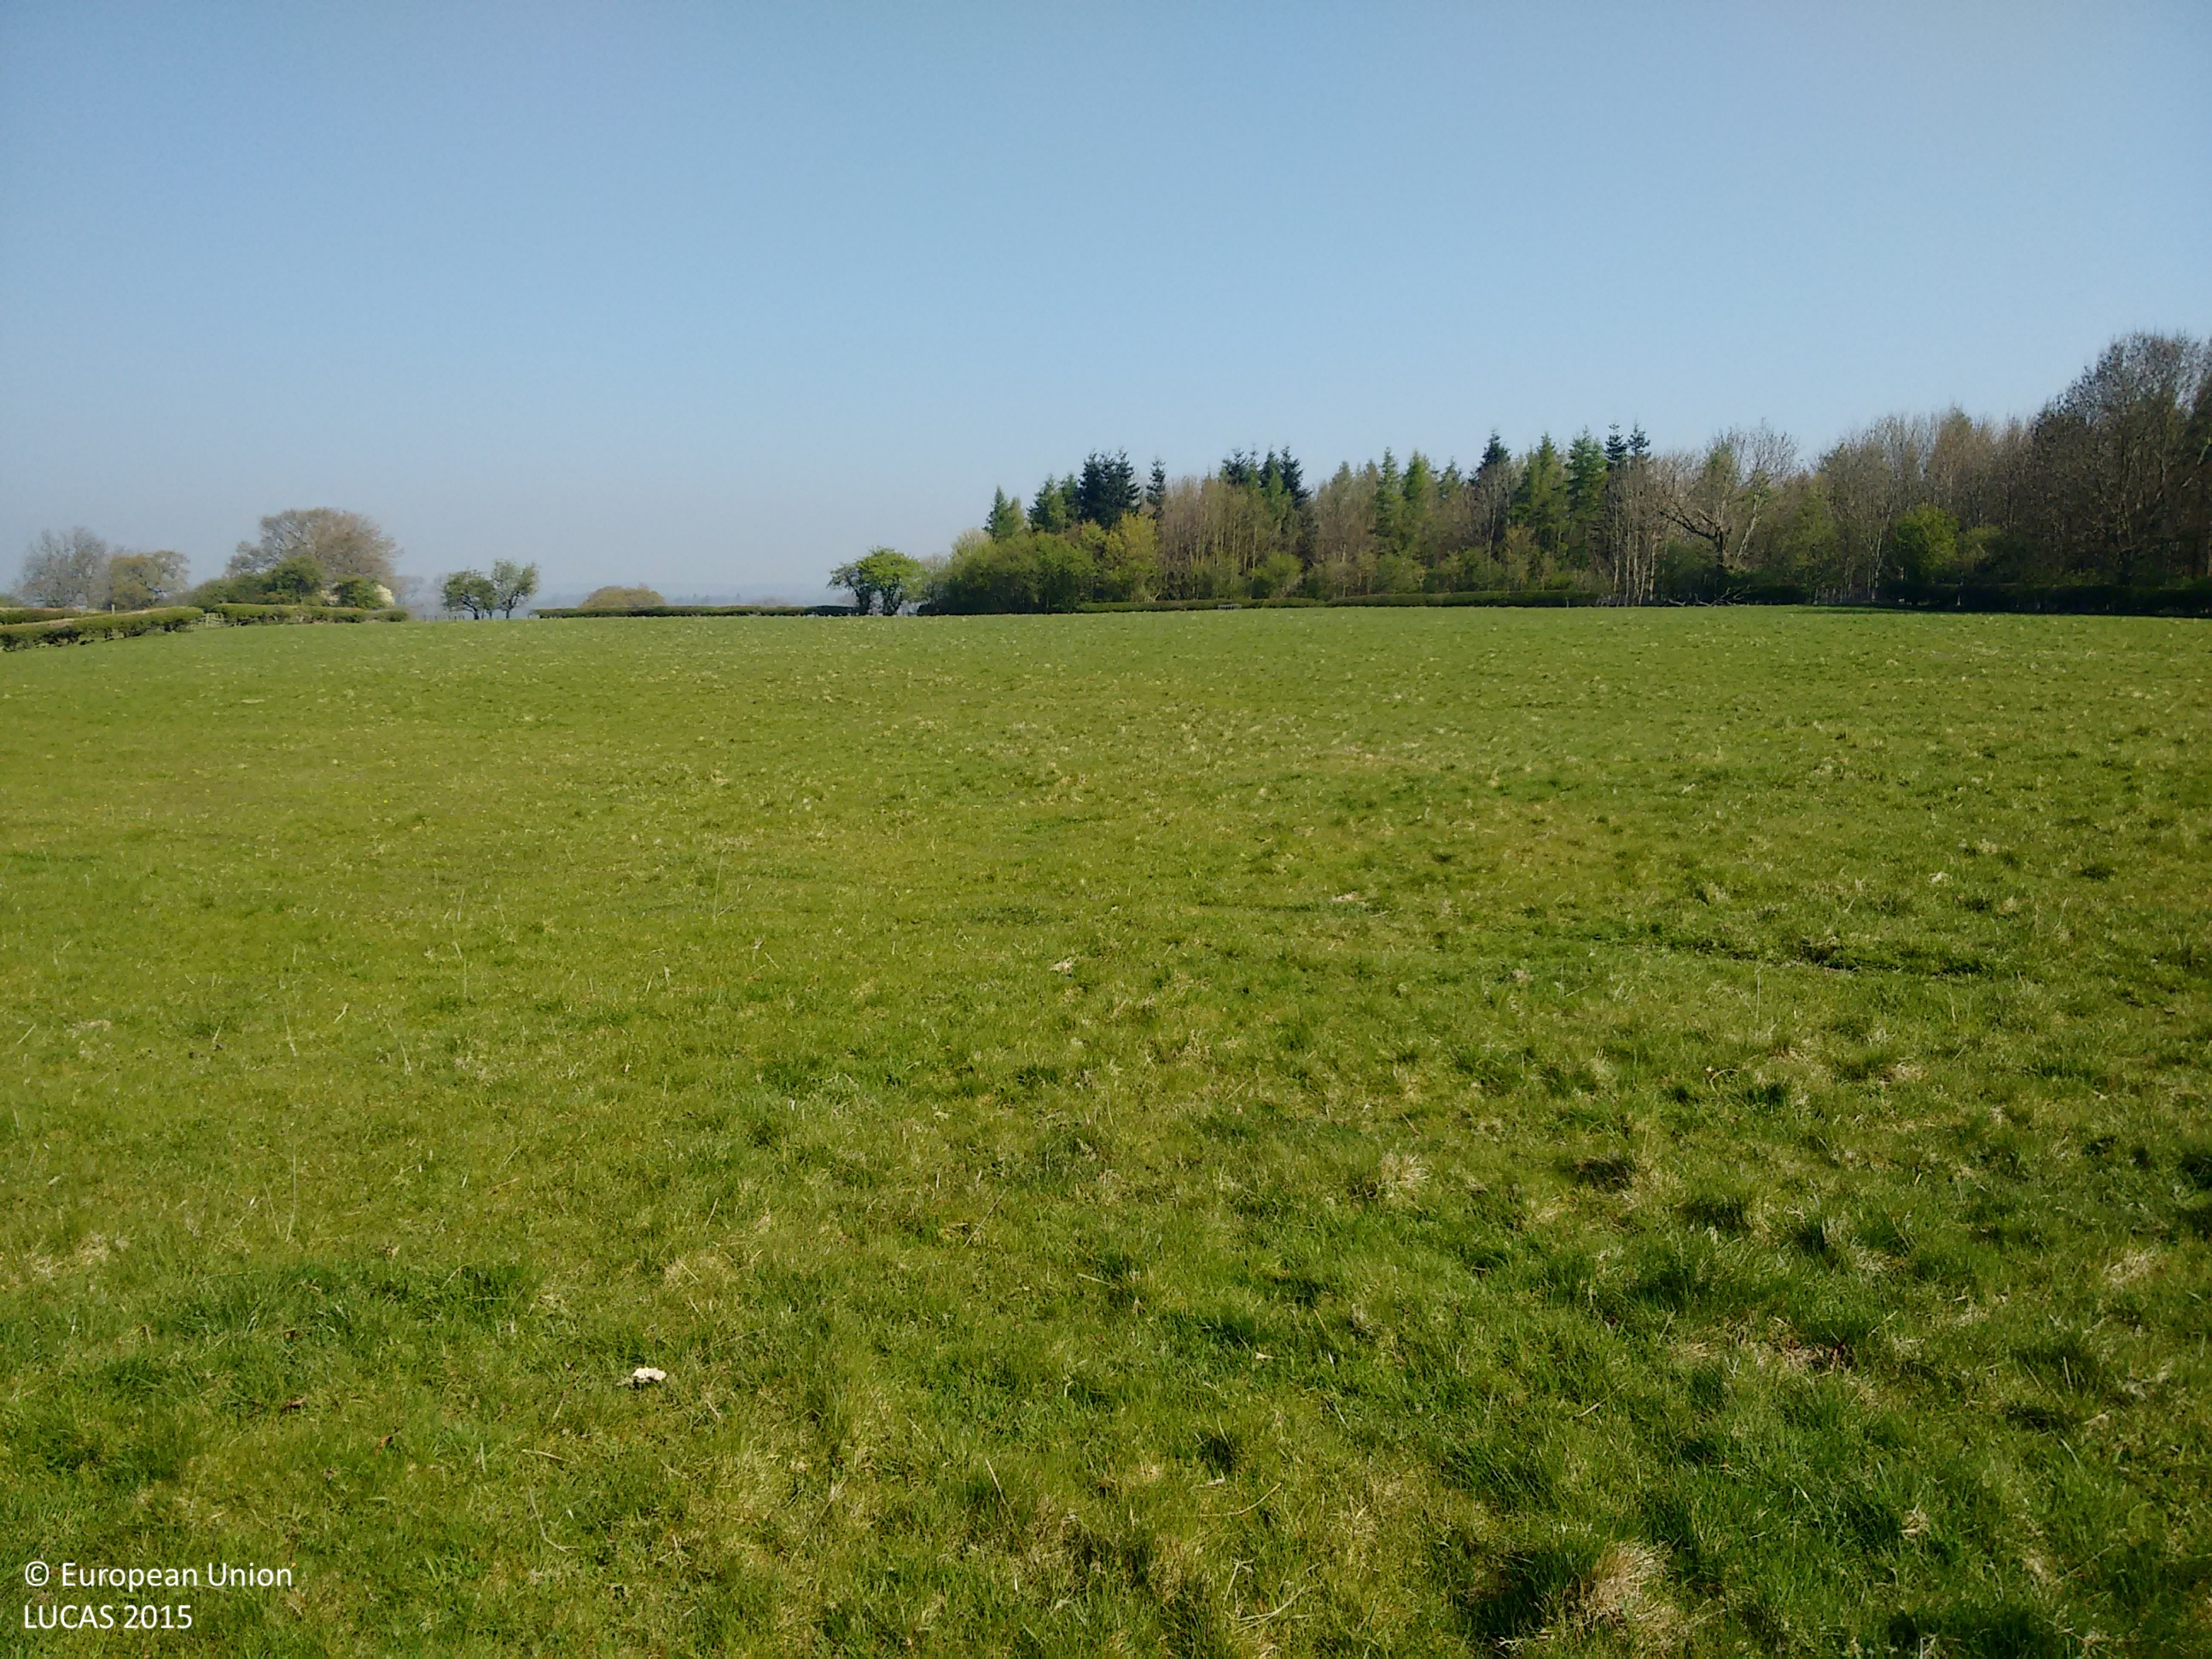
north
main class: Grassland
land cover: Grassland without tree/shrub cover
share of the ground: > 75 %
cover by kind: herbaceous plants 100 %
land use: Agriculture (excluding fallow land and kitchen gardens)
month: April
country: GB
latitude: 53.9023
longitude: -1.7265
